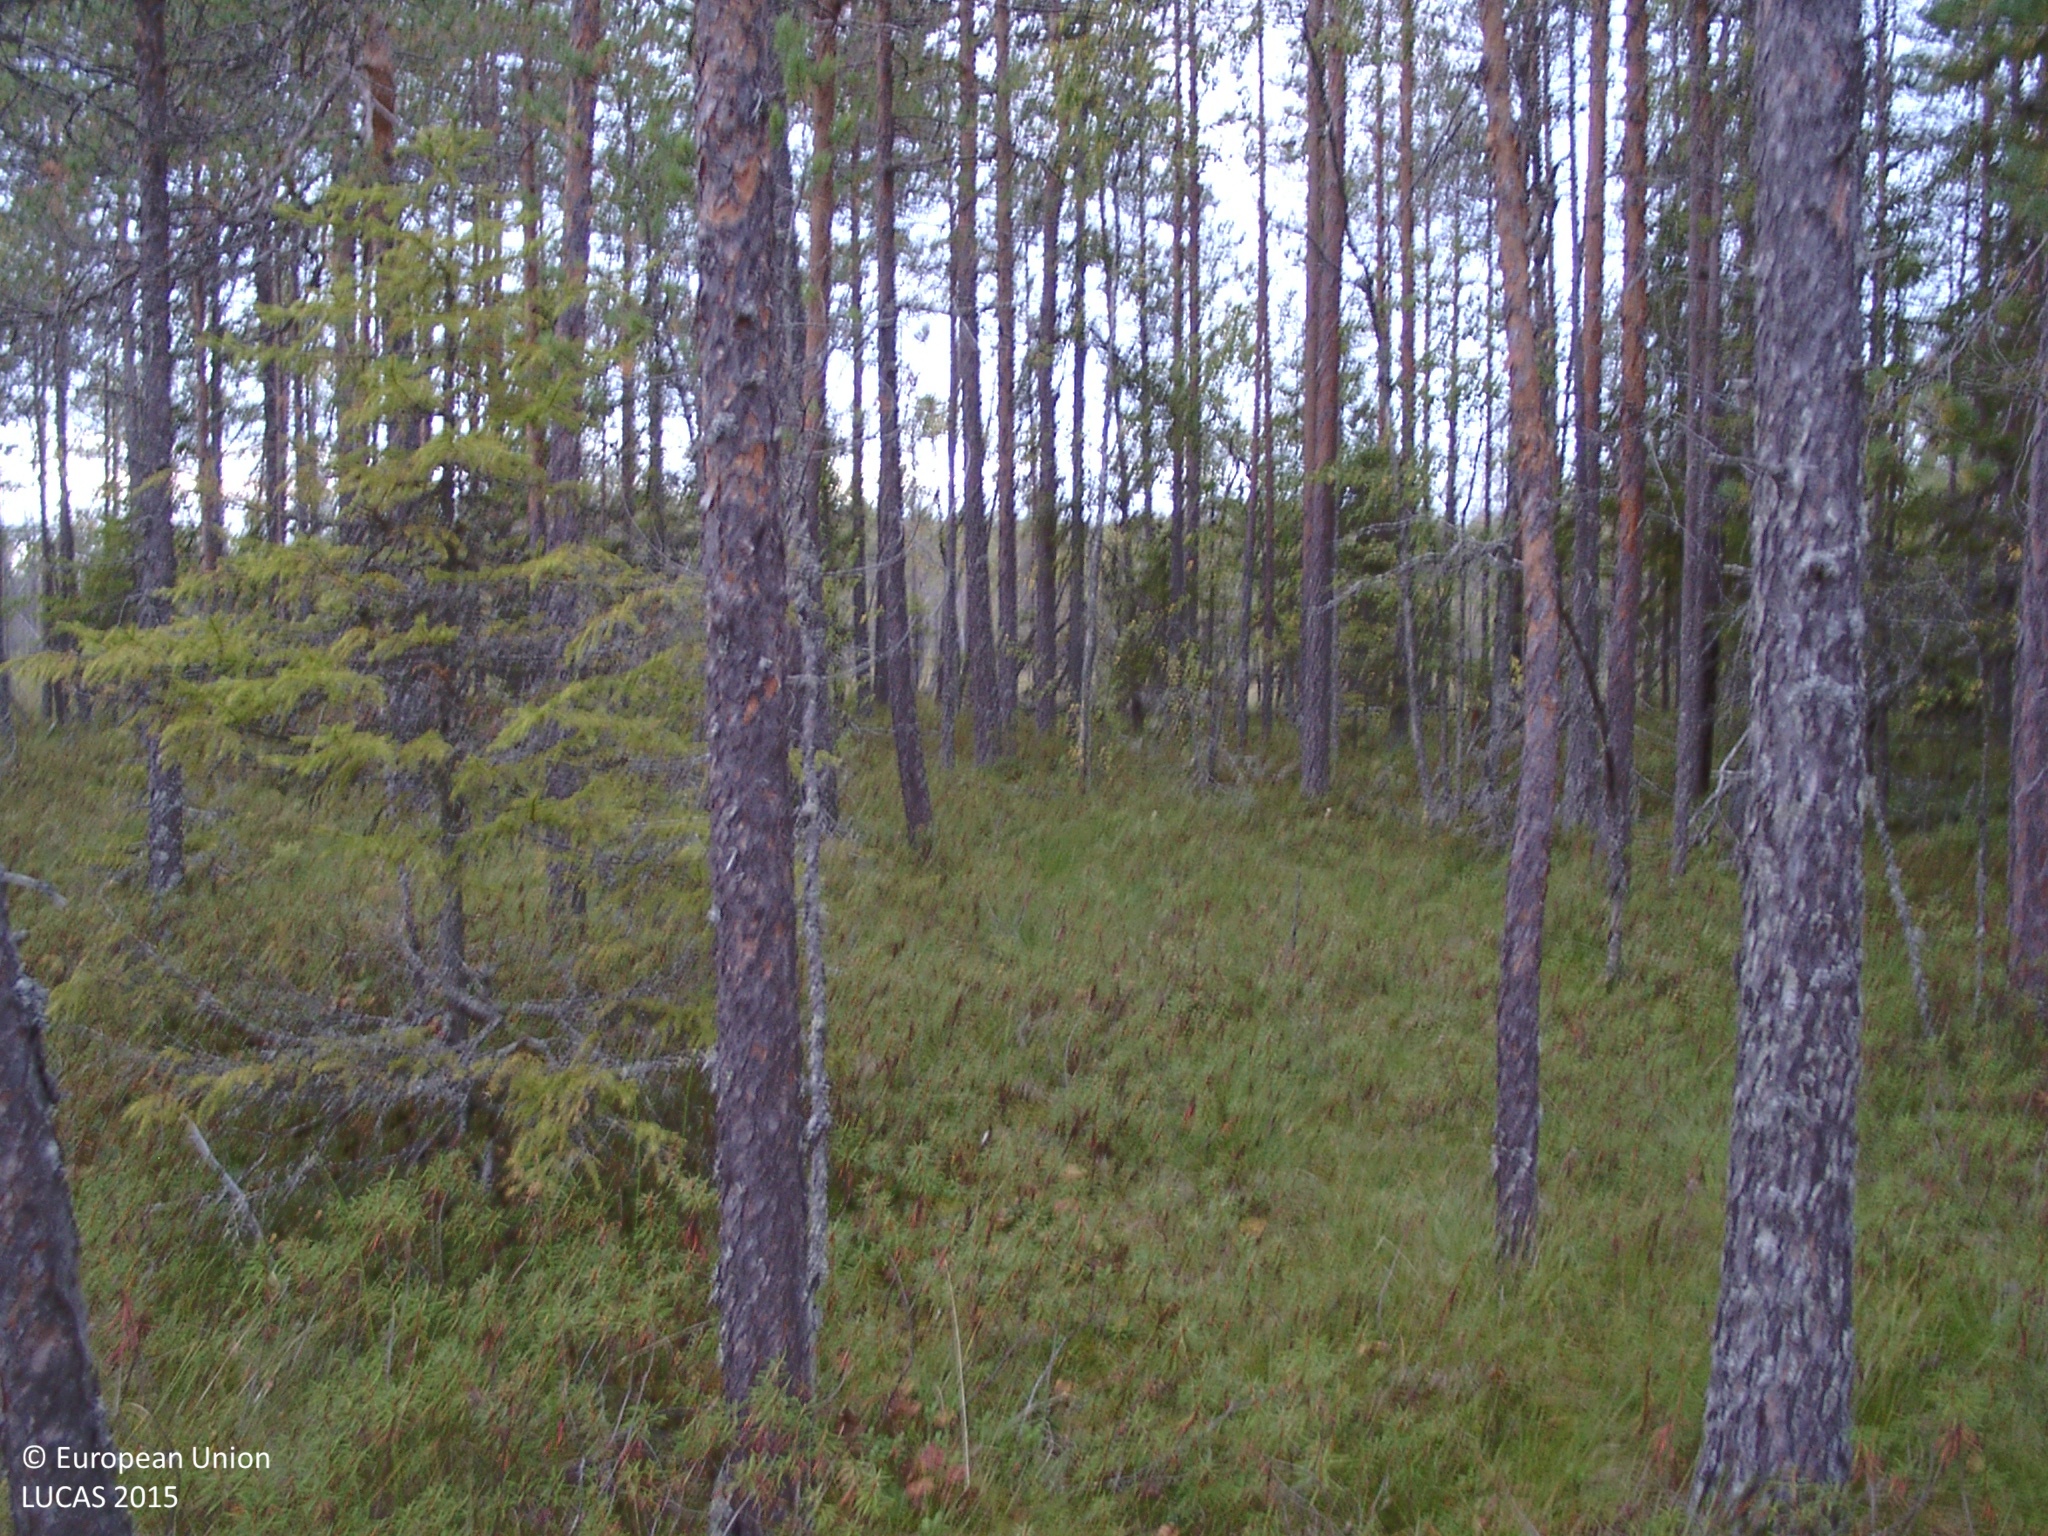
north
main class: Woodland
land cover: Pine dominated coniferous woodland
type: mire and swamp forests
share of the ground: 25 - 50 %
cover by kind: coniferous forest trees 45 %, shrubs 20 %, herbaceous plants 20 %, lichens and mosses 15 %
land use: Amenities, museums, leisure
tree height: > 5 m
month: September
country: FI
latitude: 62.8549
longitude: 25.4910
